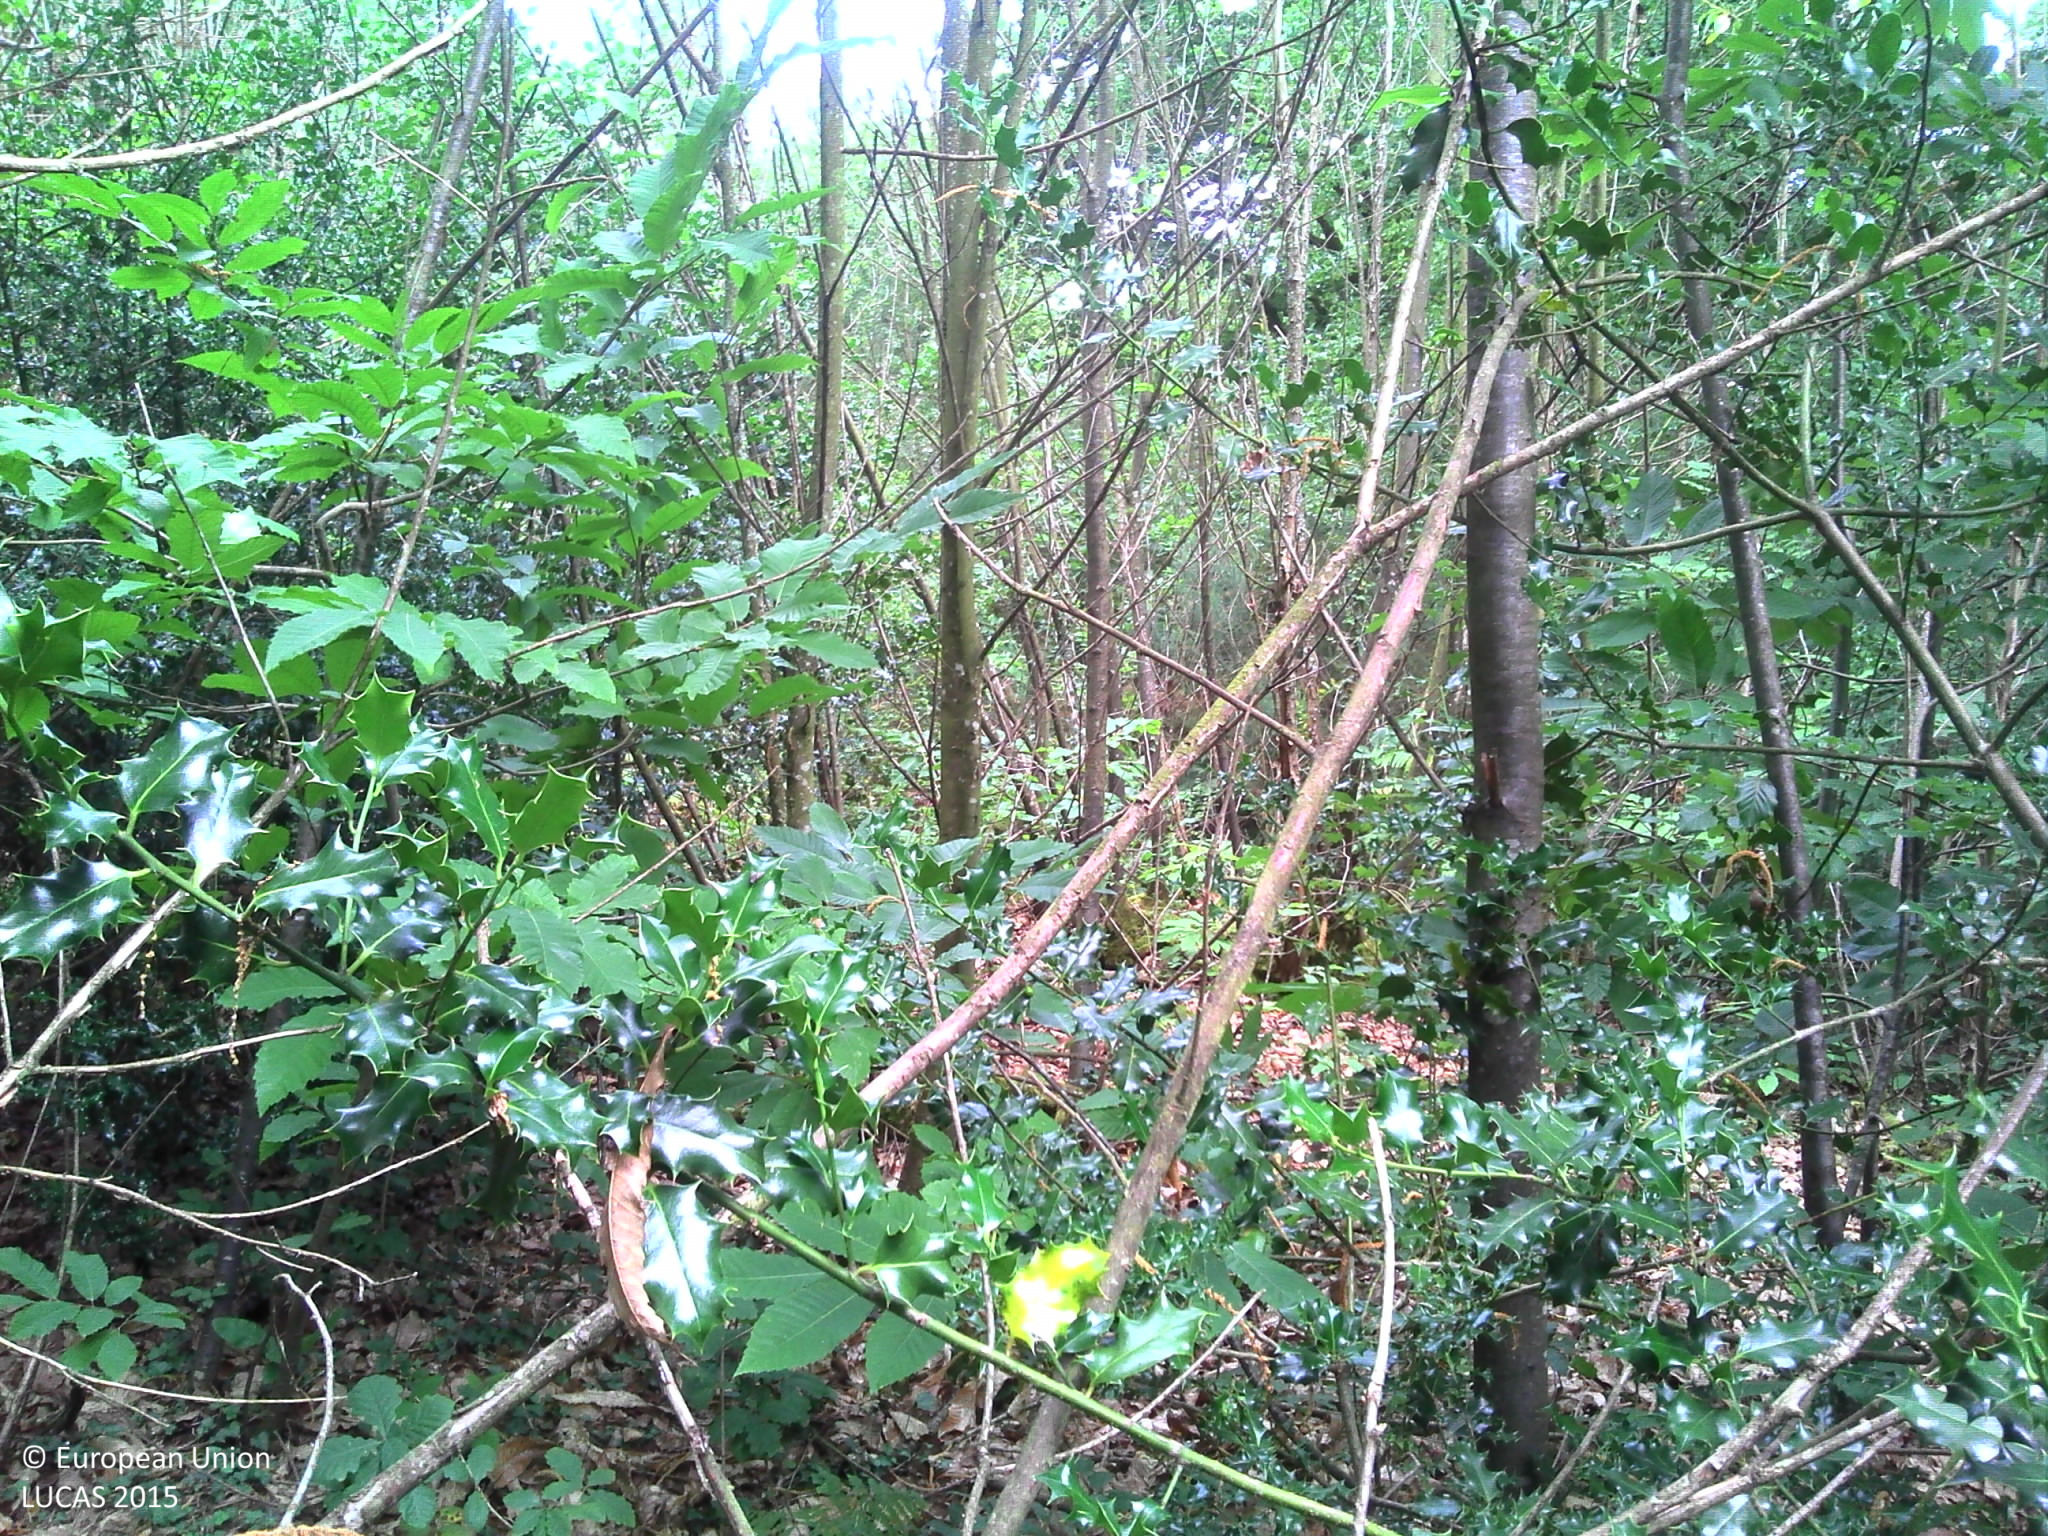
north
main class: Woodland
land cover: Broadleaved woodland
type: acidophilous oak and oak-birch forest
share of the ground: > 75 %
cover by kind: broadleaved forest trees 95 %, herbaceous plants 5 %
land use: Forestry
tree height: > 5 m
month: July
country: FR
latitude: 47.5856
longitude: -1.8151
